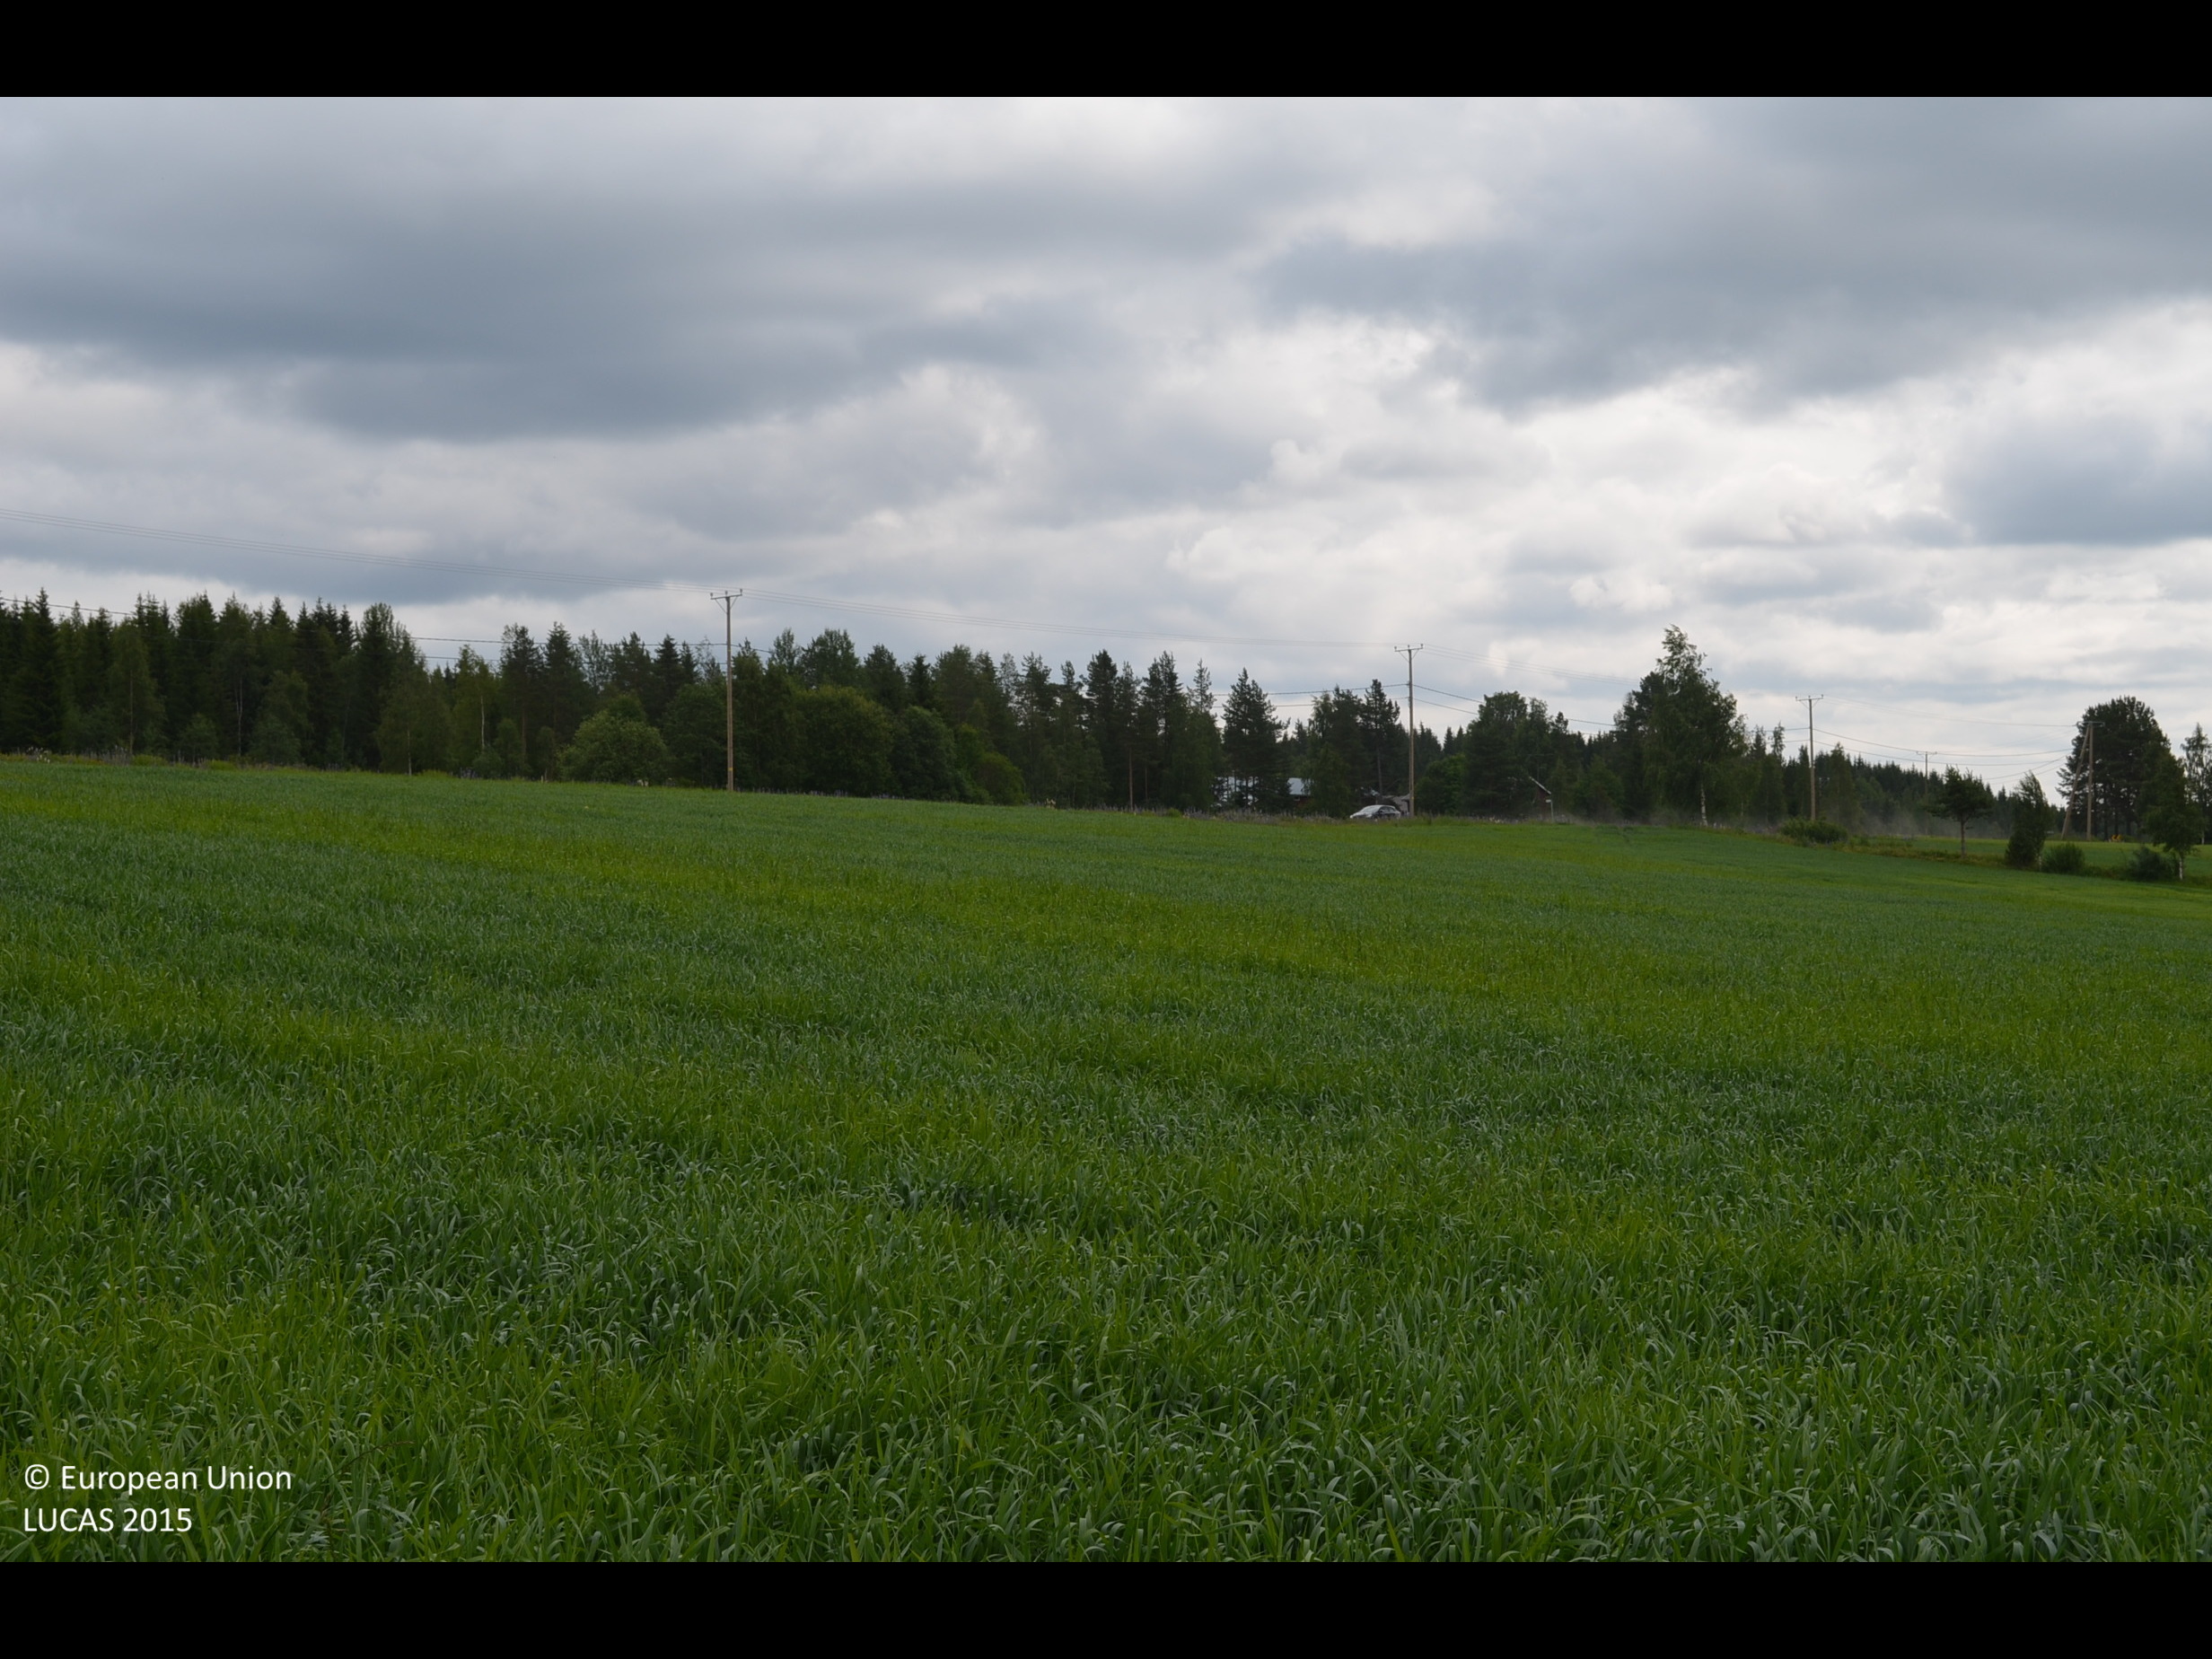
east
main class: Cropland
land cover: Common wheat
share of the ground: > 75 %
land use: Agriculture (excluding fallow land and kitchen gardens)
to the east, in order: Common wheat; Electric lines; Grass margins; Ditches and canals; Grass margins; Paved roads, cycling and walking lanes; Grass margins; Ditches and canals; Grass margins; Barley; Rock outcrops; Barley; Grass margins; Ditches and canals; Grass margins; Barley; Grass margins; Ditches and canals; Grass margins; Temporary grasslands
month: July
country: FI
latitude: 62.1560
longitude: 23.6062
